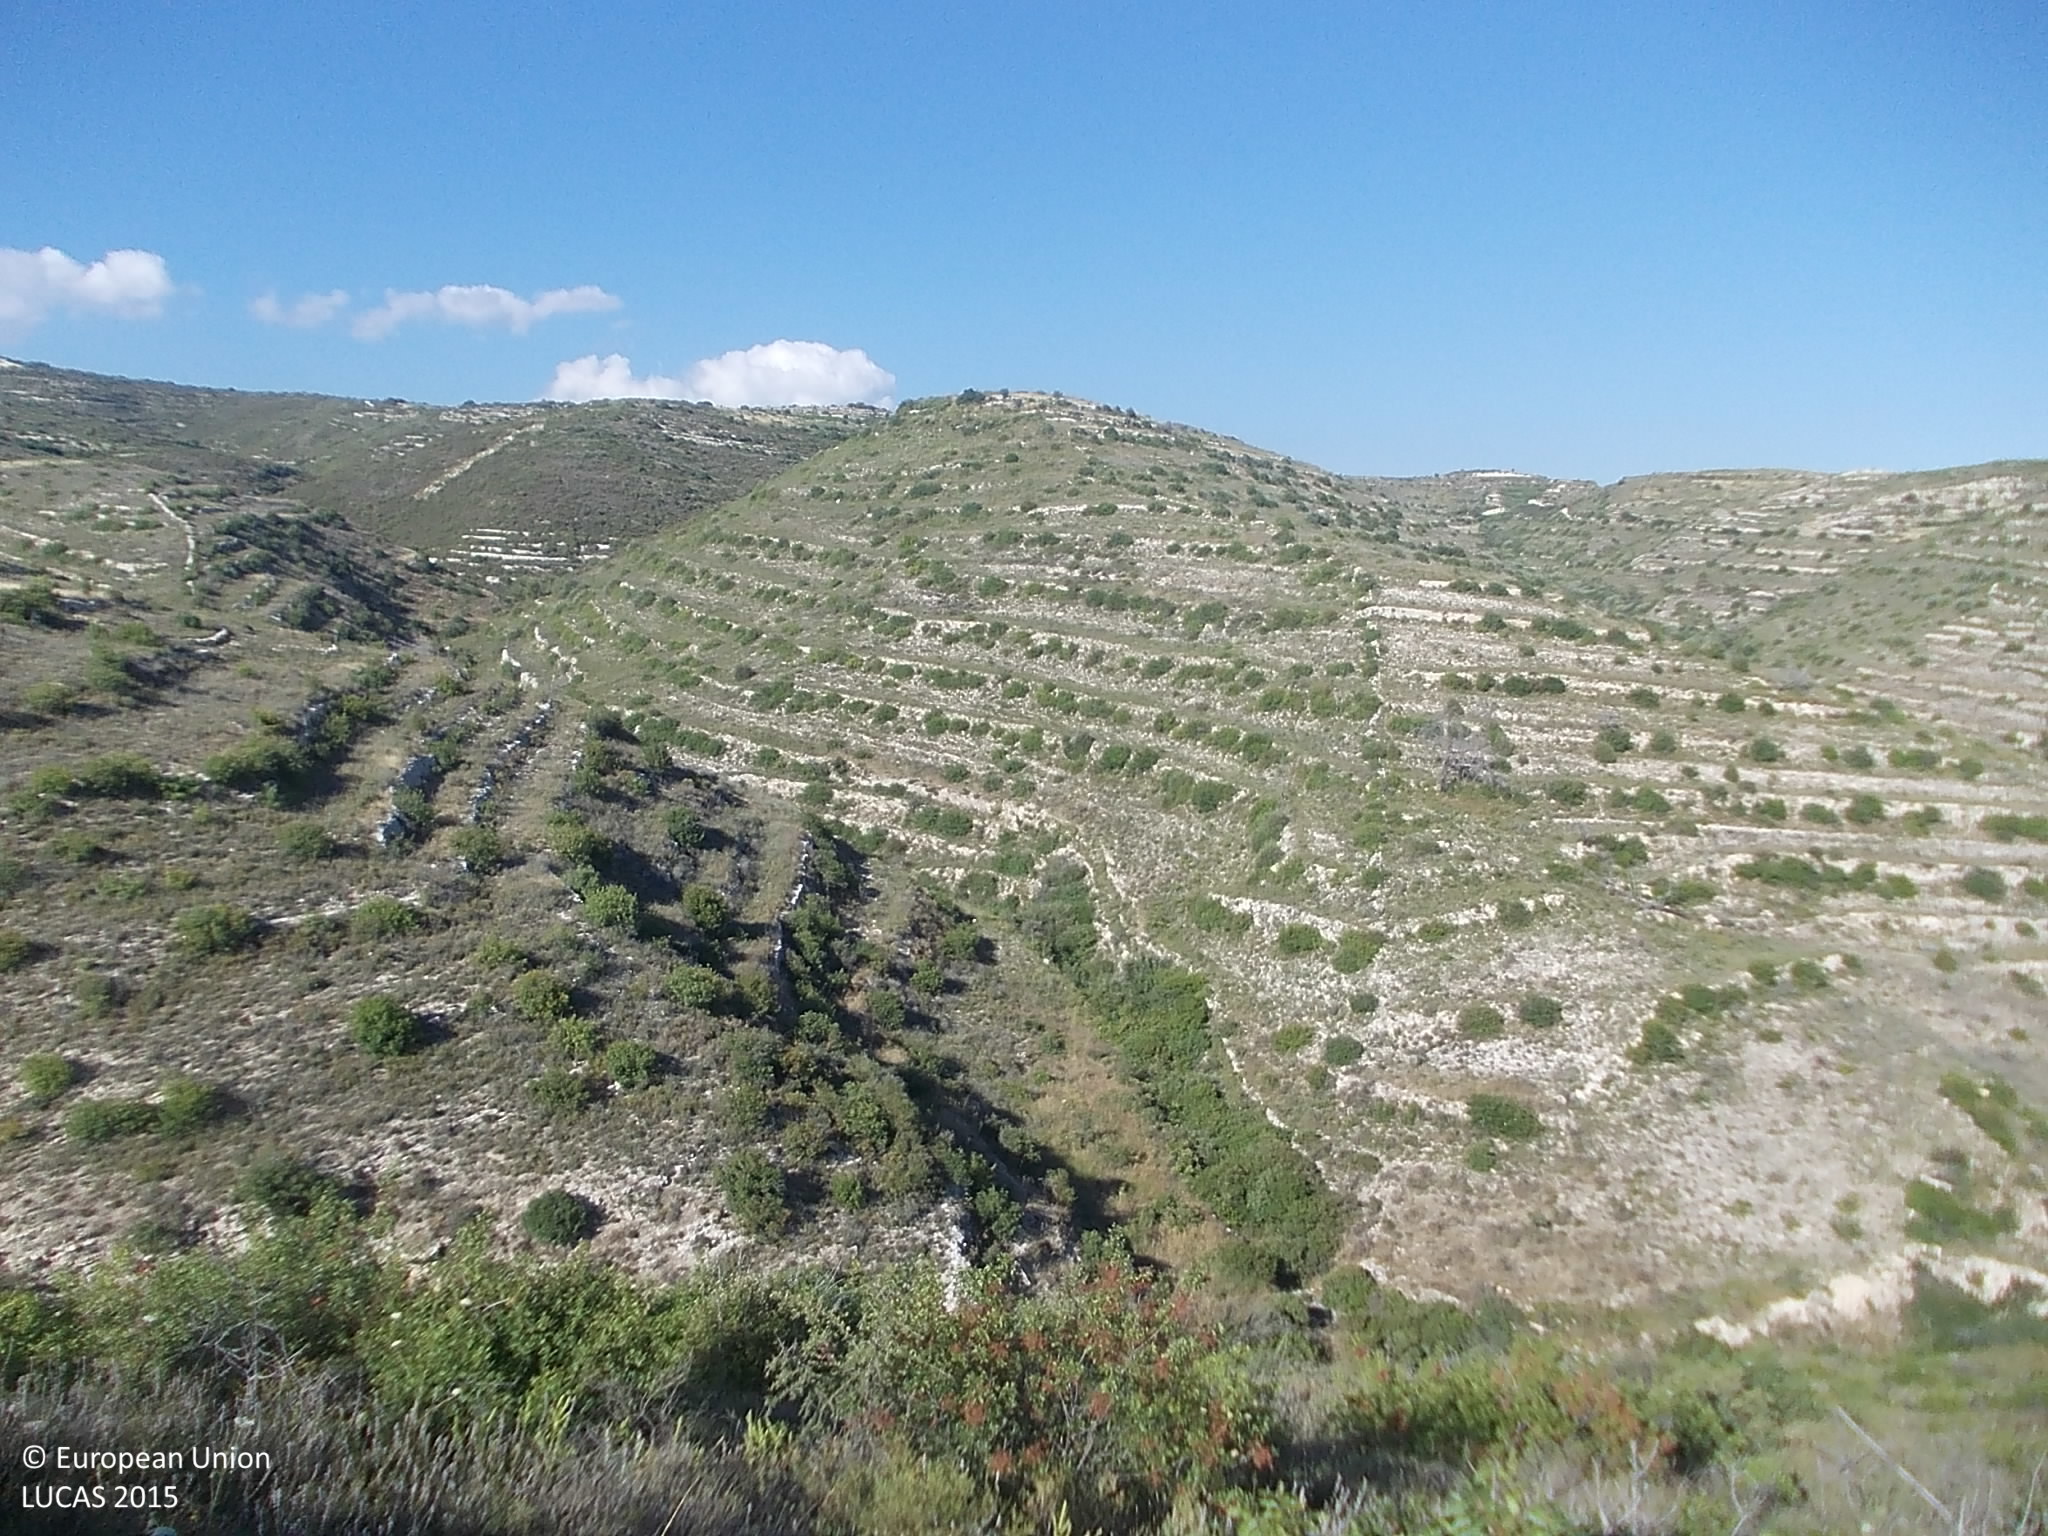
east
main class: Shrubland
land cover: Shrubland without tree cover
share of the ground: 50 - 75 %
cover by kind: shrubs 65 %, unconsolidated bare surface 20 %, herbaceous plants 15 %
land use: Semi-natural and natural areas not in use
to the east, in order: Shrubland without tree cover
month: July
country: CY
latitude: 34.8372
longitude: 32.8304
